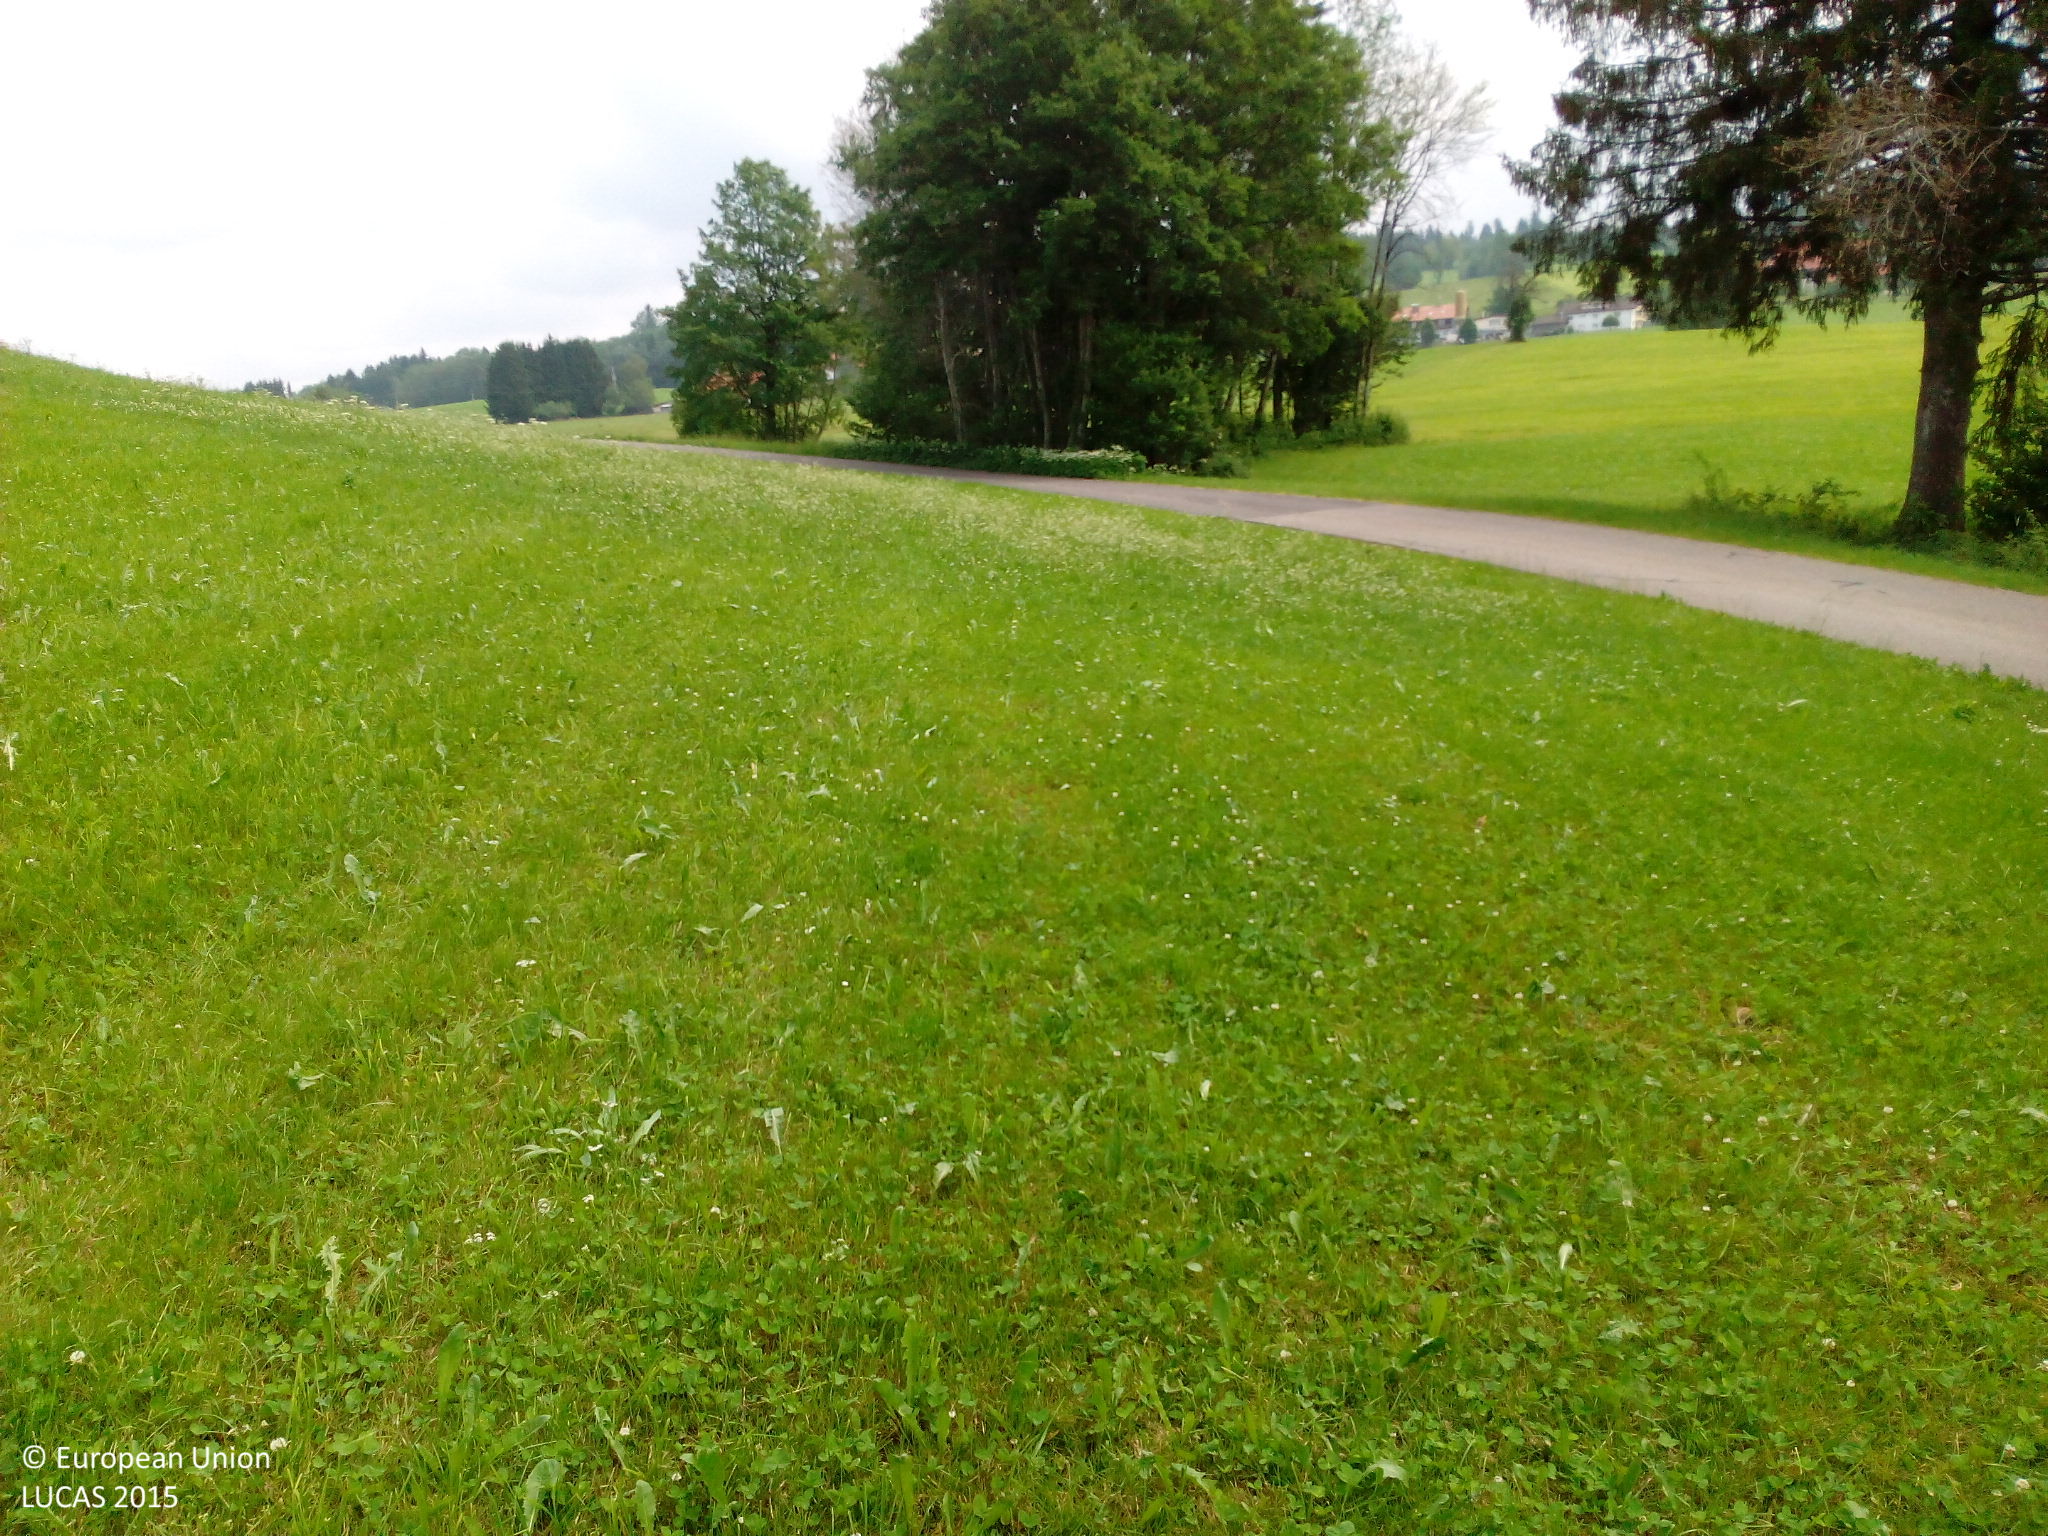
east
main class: Grassland
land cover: Grassland without tree/shrub cover
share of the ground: > 75 %
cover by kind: herbaceous plants 100 %
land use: Agriculture (excluding fallow land and kitchen gardens)
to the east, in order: Grassland without tree/shrub cover; Paved roads, cycling and walking lanes; Grassland without tree/shrub cover; Tracks; Grassland without tree/shrub cover; Fences; Grassland without tree/shrub cover
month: June
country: DE
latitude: 47.5576
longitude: 9.9336
